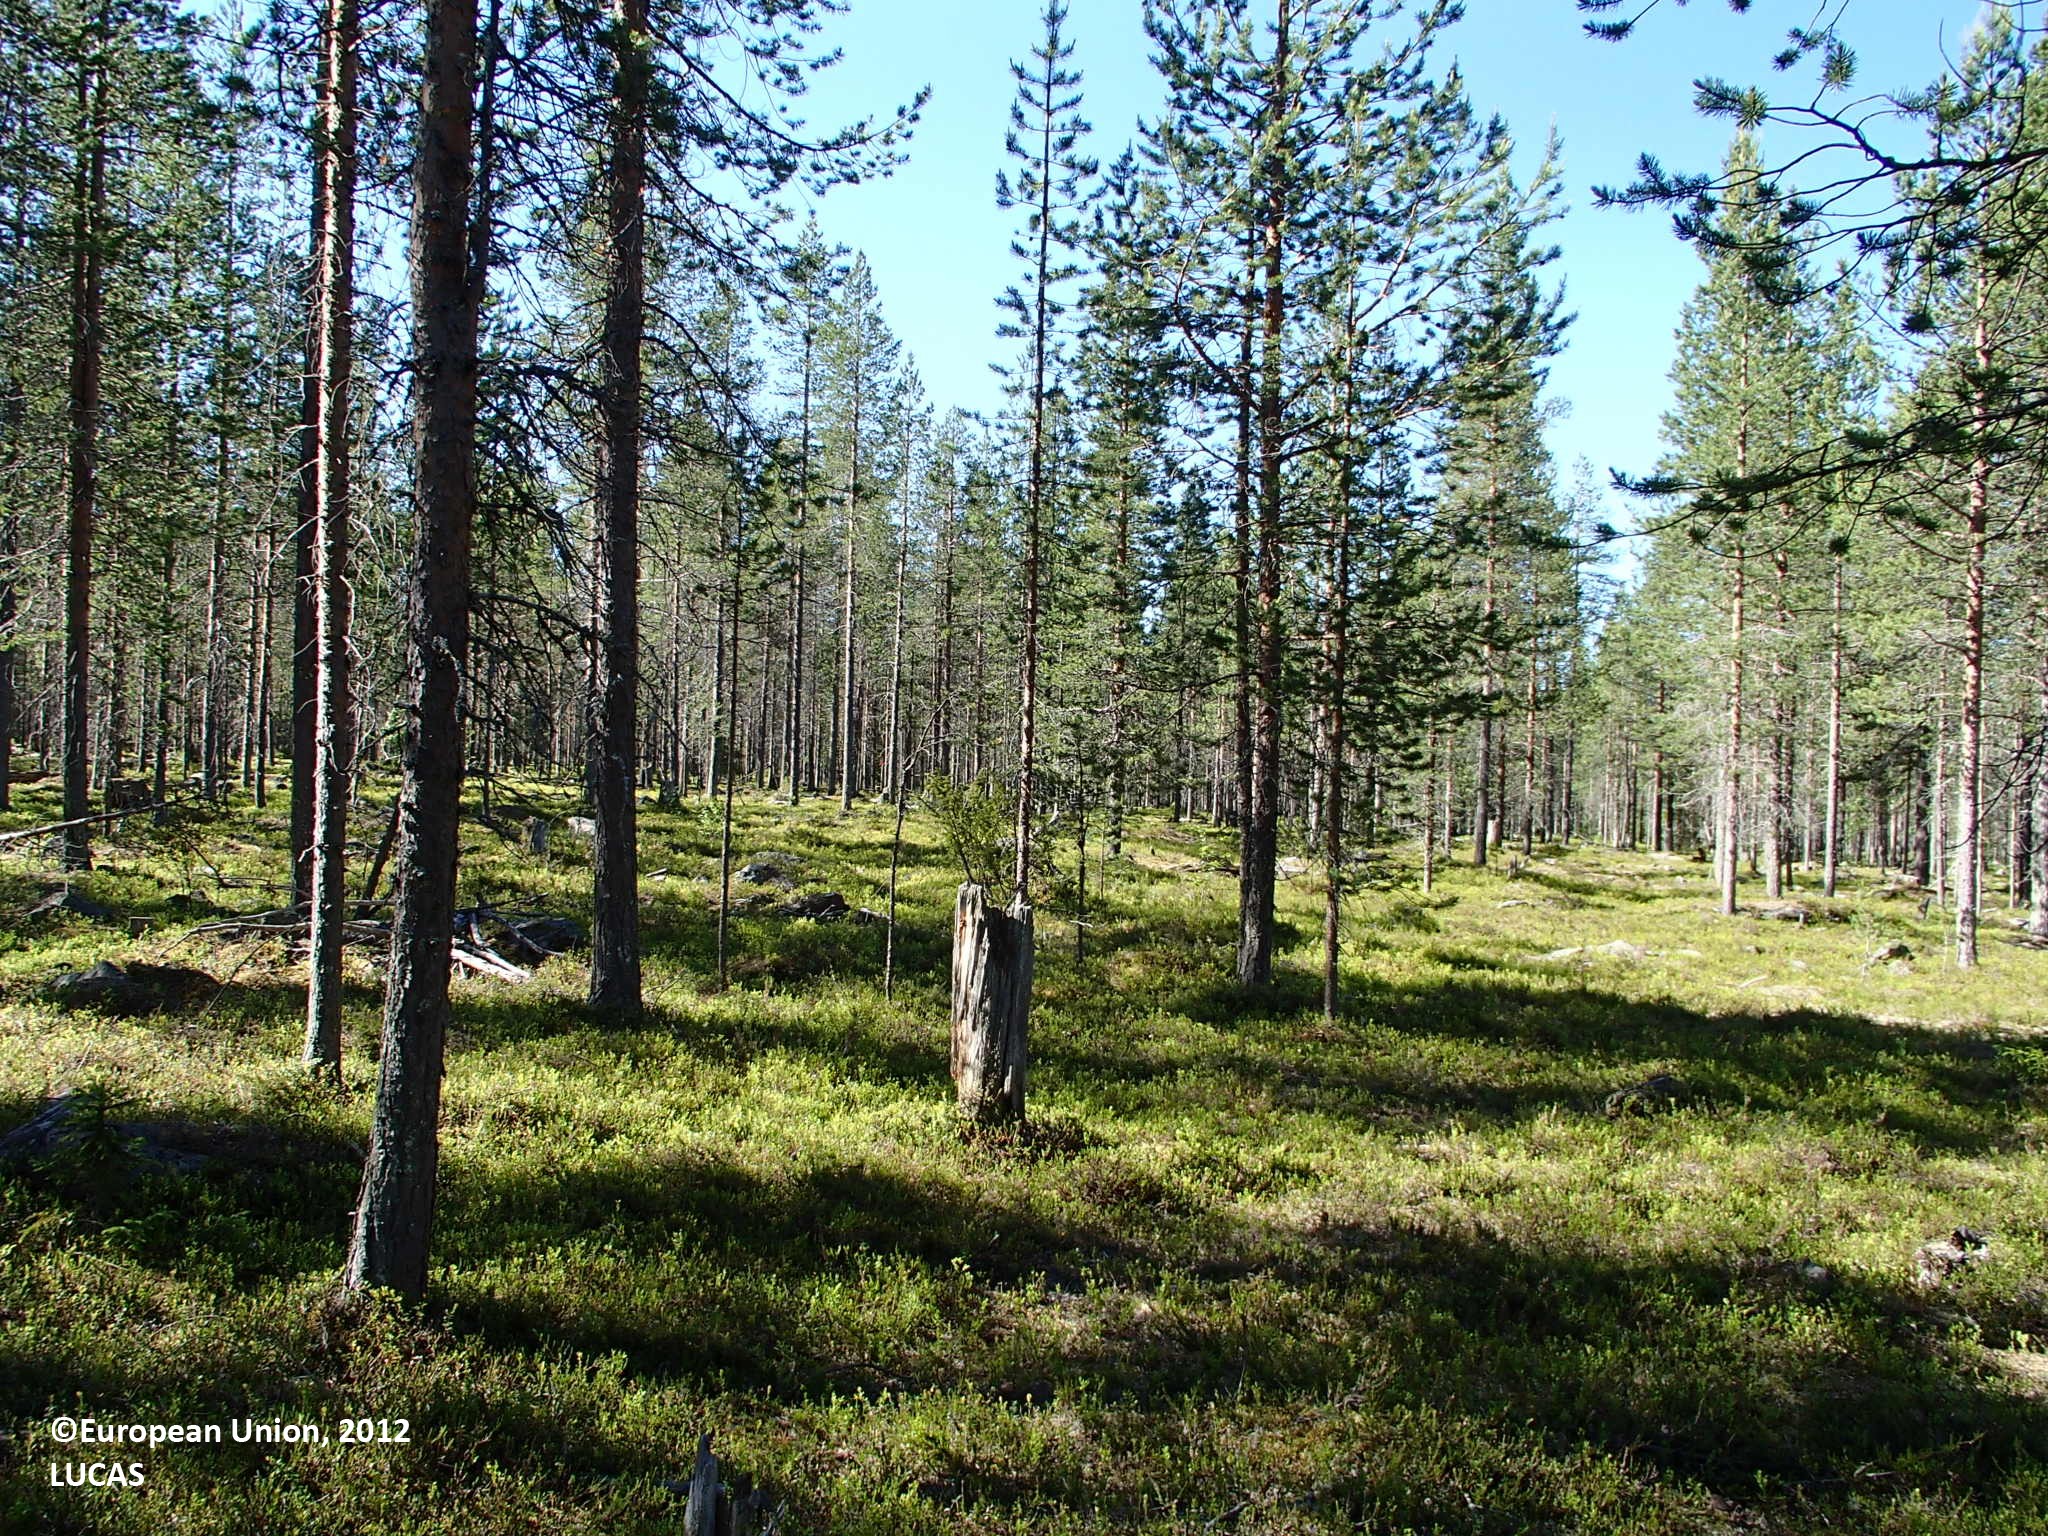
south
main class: Woodland
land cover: Pine dominated coniferous woodland
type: boreal forest
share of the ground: 25 - 50 %
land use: Forestry
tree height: > 5 m
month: July
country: FI
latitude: 67.2027
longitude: 26.7099
